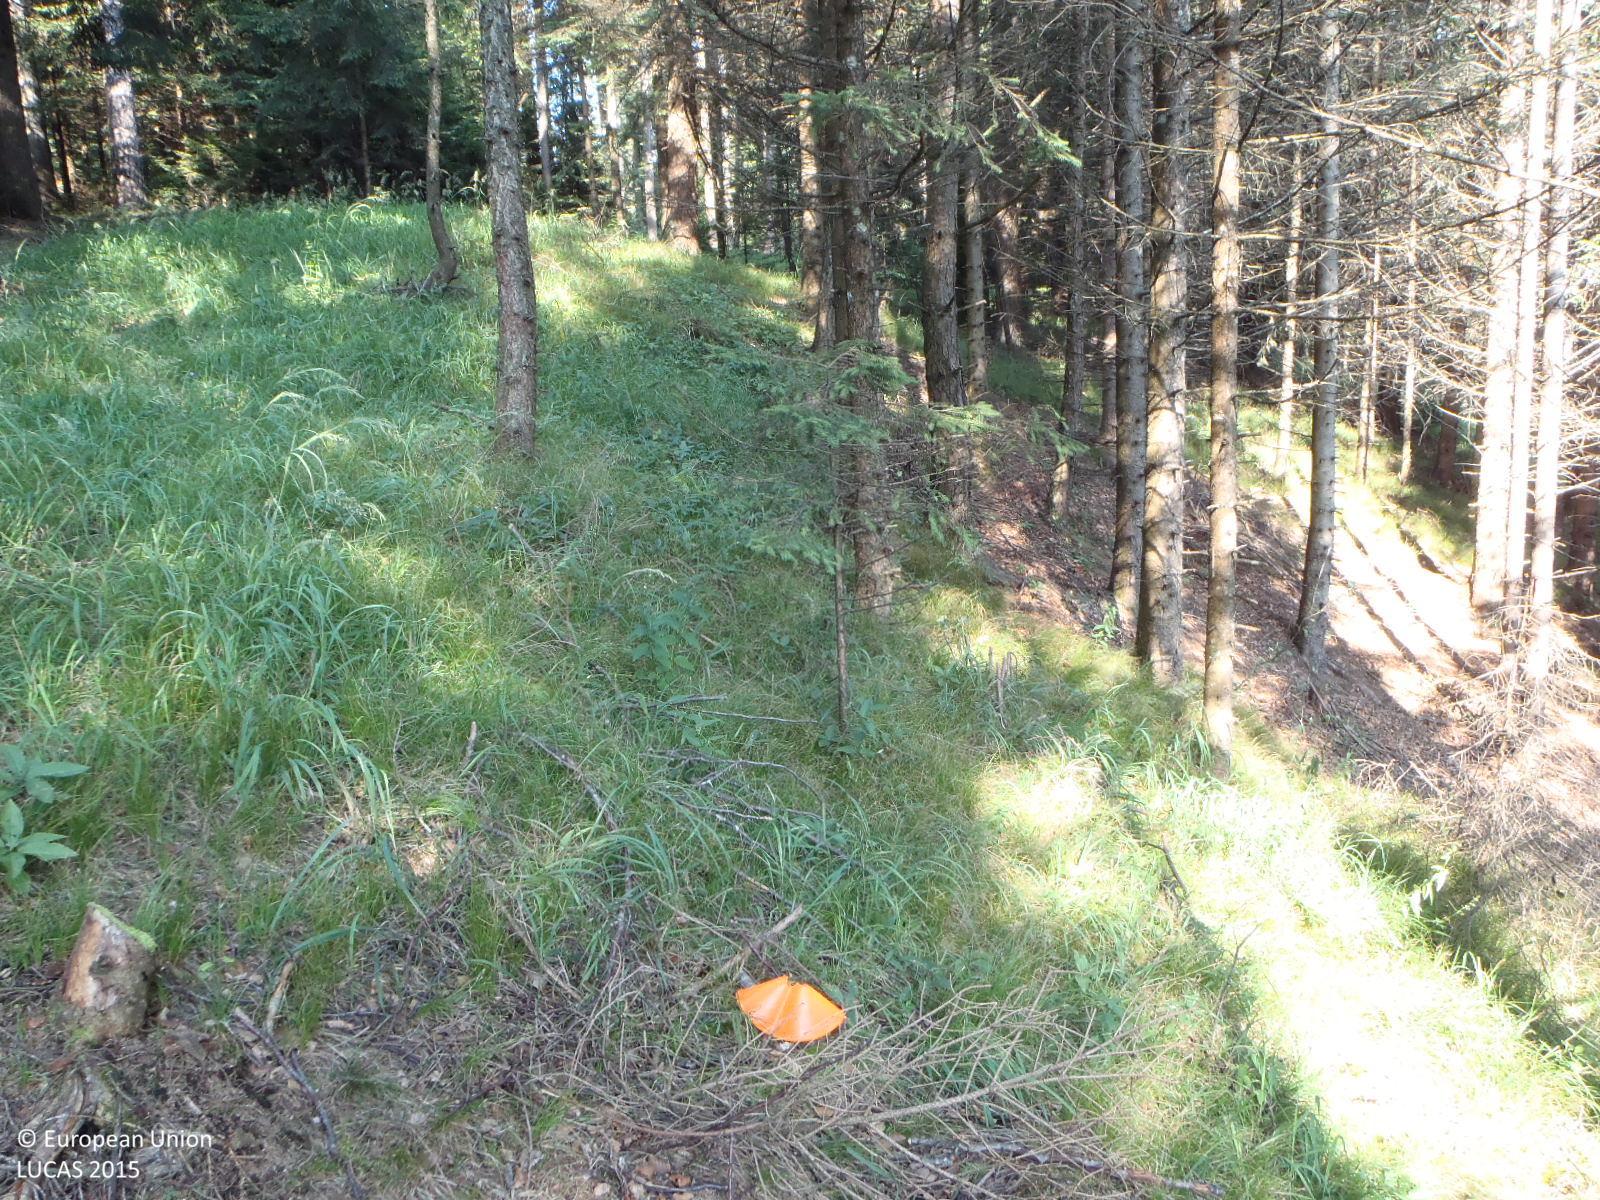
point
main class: Woodland
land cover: Spruce dominated mixed woodland
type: alpine coniferous forest
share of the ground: > 75 %
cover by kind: coniferous forest trees 70 %, broadleaved forest trees 25 %, herbaceous plants 5 %
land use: Forestry
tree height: > 5 m
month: July
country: AT
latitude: 47.4331
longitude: 11.8945
